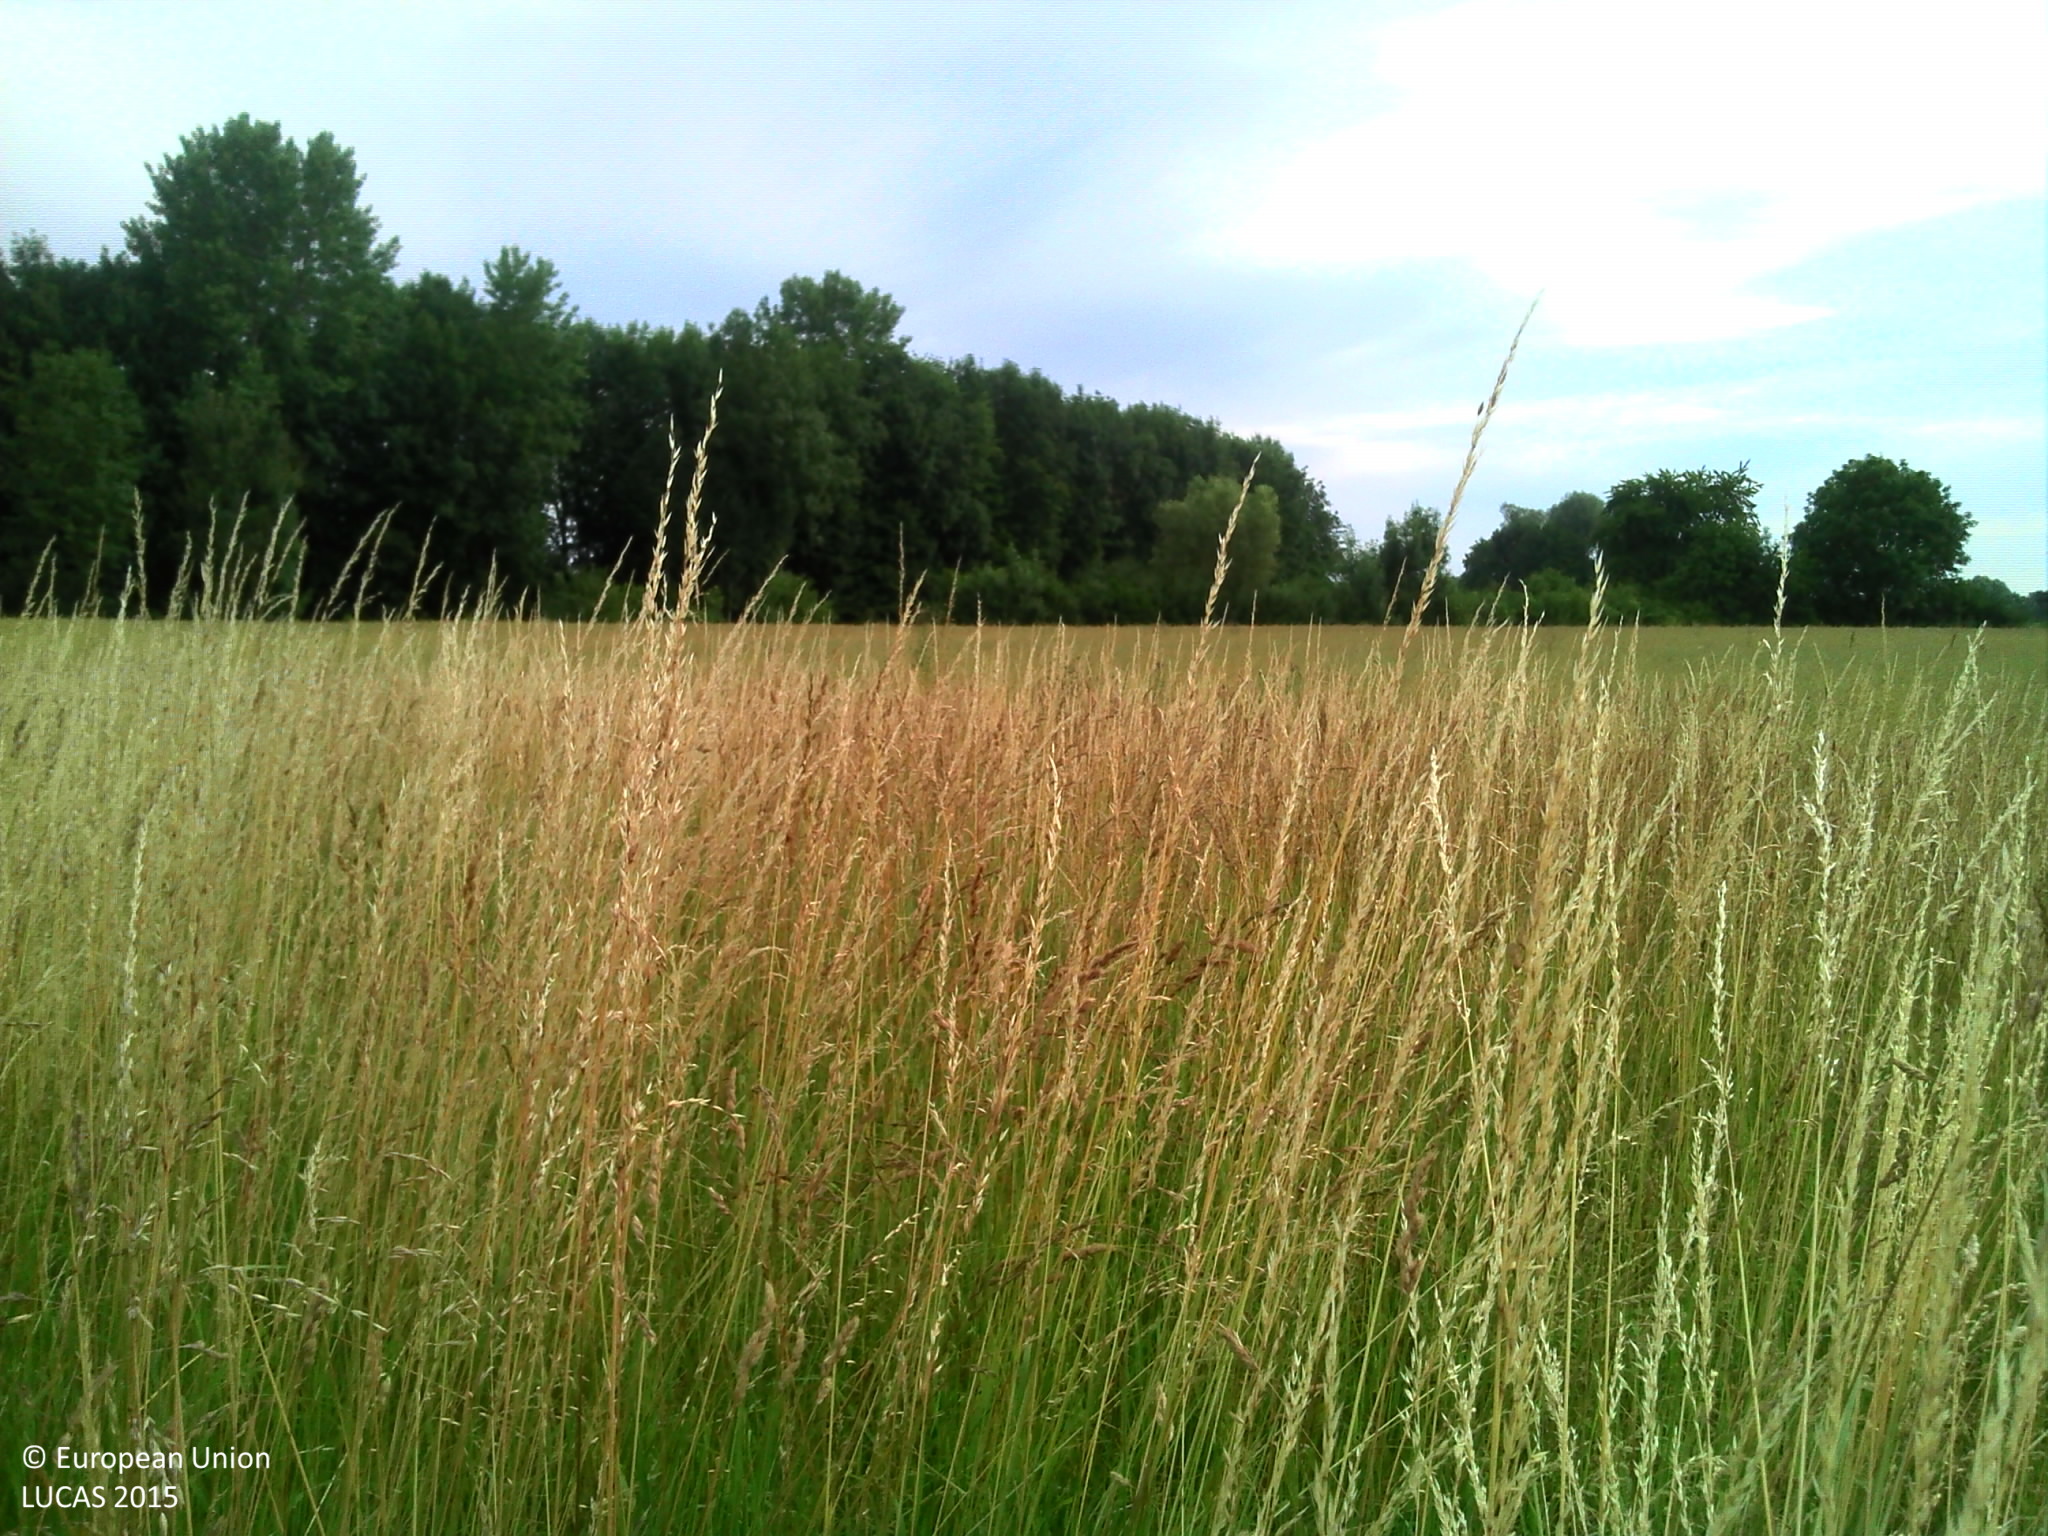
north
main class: Grassland
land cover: Grassland without tree/shrub cover
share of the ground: > 75 %
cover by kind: herbaceous plants 100 %
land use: Agriculture (excluding fallow land and kitchen gardens)
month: June
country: FR
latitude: 48.8274
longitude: 4.9169
